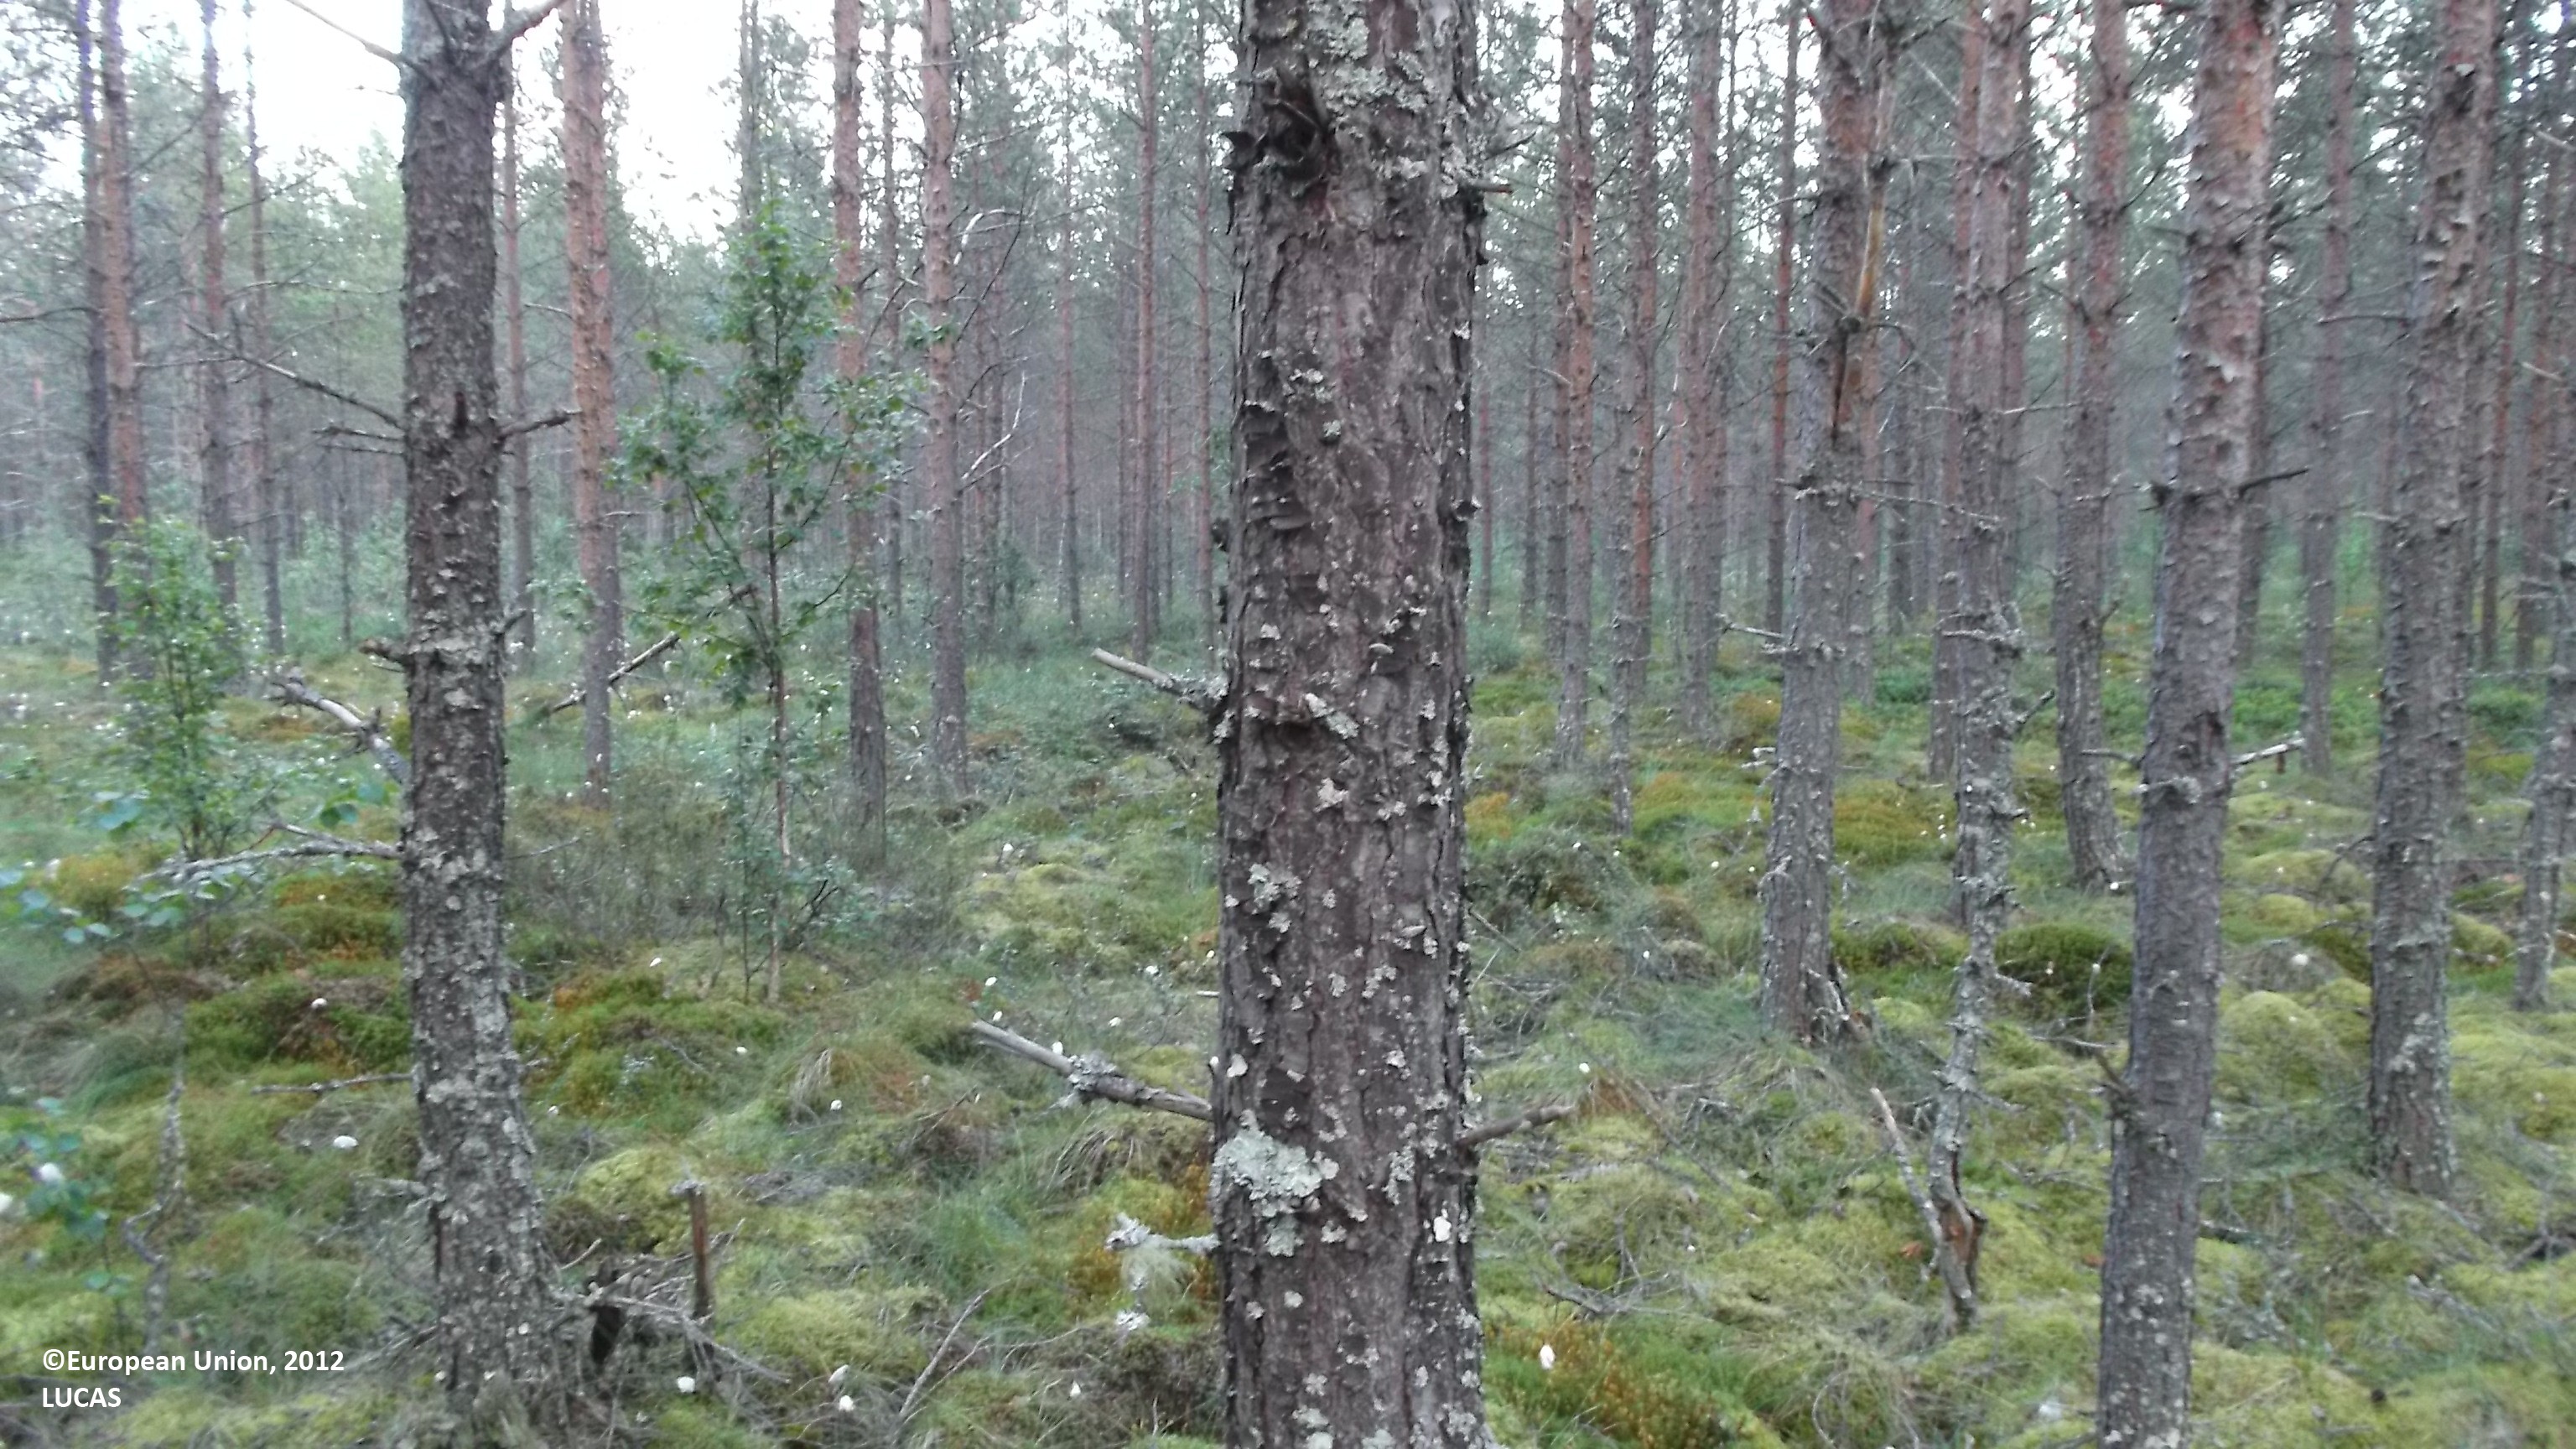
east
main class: Woodland
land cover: Pine dominated coniferous woodland
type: mire and swamp forests
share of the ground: 25 - 50 %
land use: Semi-natural and natural areas not in use
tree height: > 5 m
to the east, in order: Pine dominated coniferous woodland; Ditches and canals; Pine dominated coniferous woodland; Ditches and canals; Pine dominated coniferous woodland; Ditches and canals; Pine dominated coniferous woodland; Ditches and canals; Pine dominated coniferous woodland
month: July
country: FI
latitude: 63.3632
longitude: 24.4549
